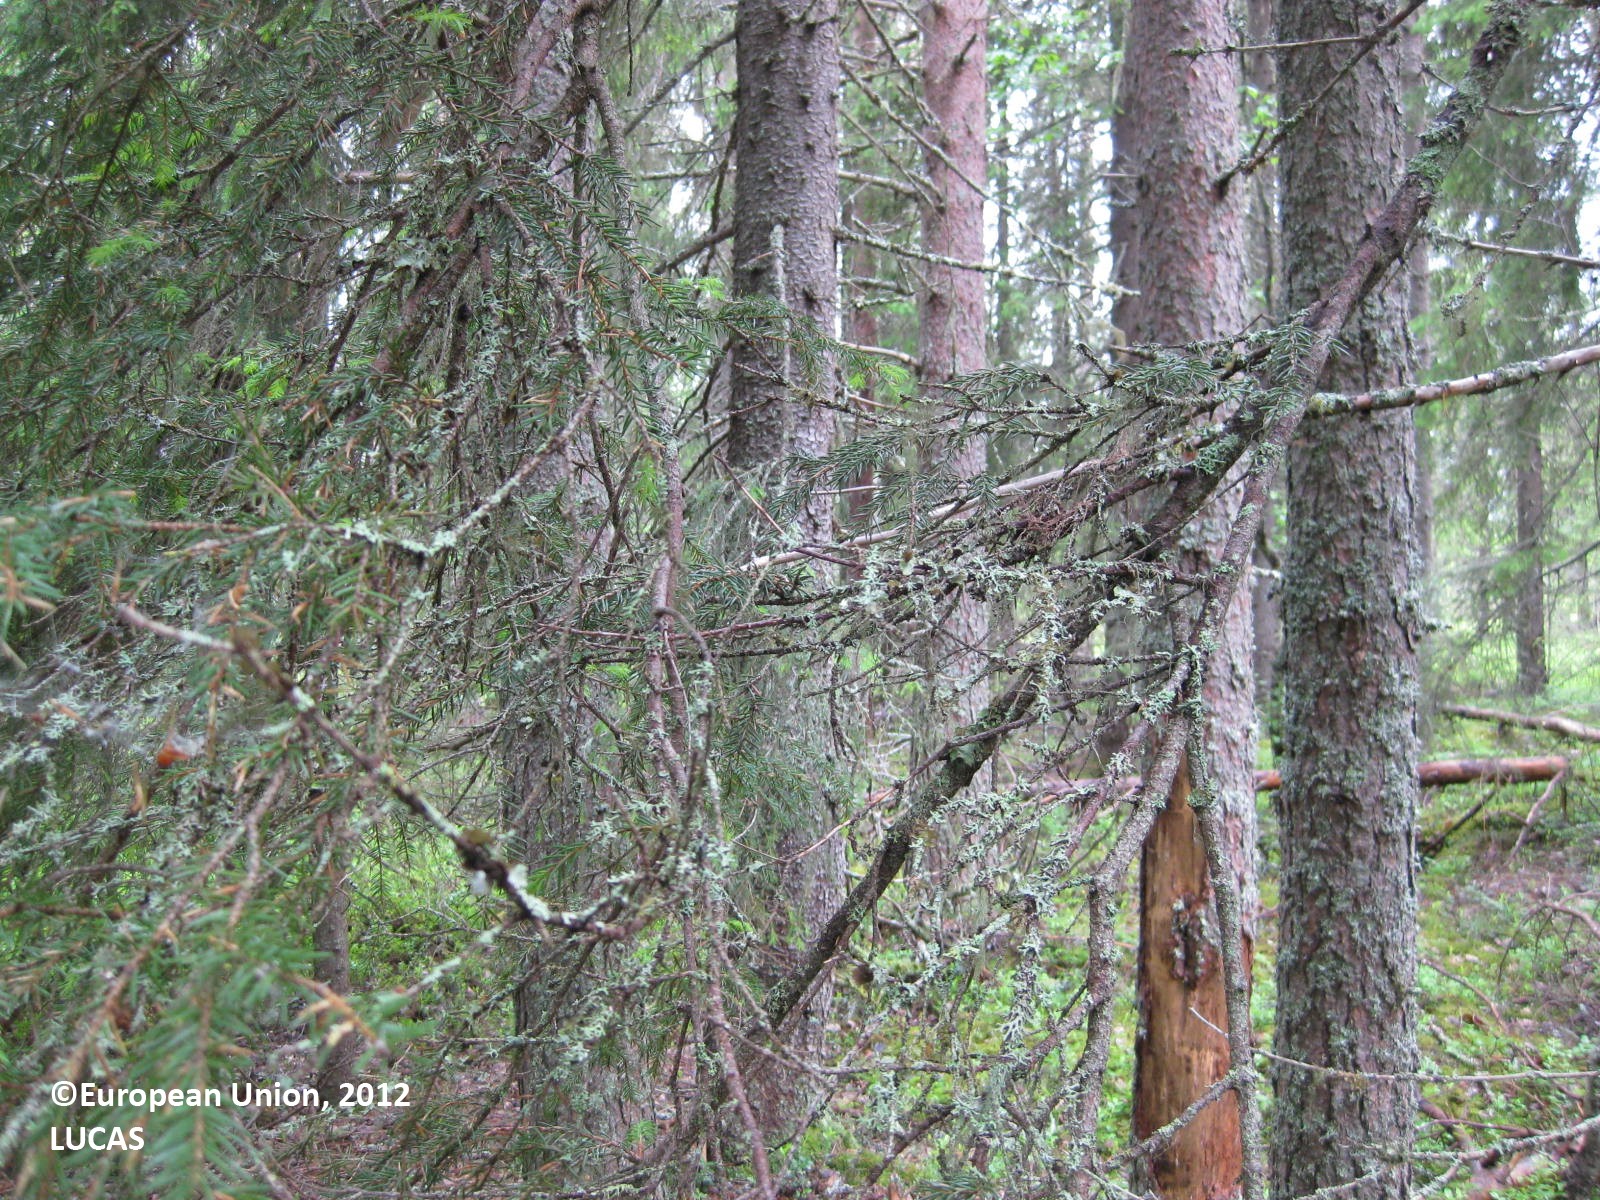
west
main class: Woodland
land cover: Other coniferous woodland
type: boreal forest
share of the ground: > 75 %
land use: Forestry
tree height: > 5 m
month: June
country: FI
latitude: 65.2357
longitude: 28.1912
